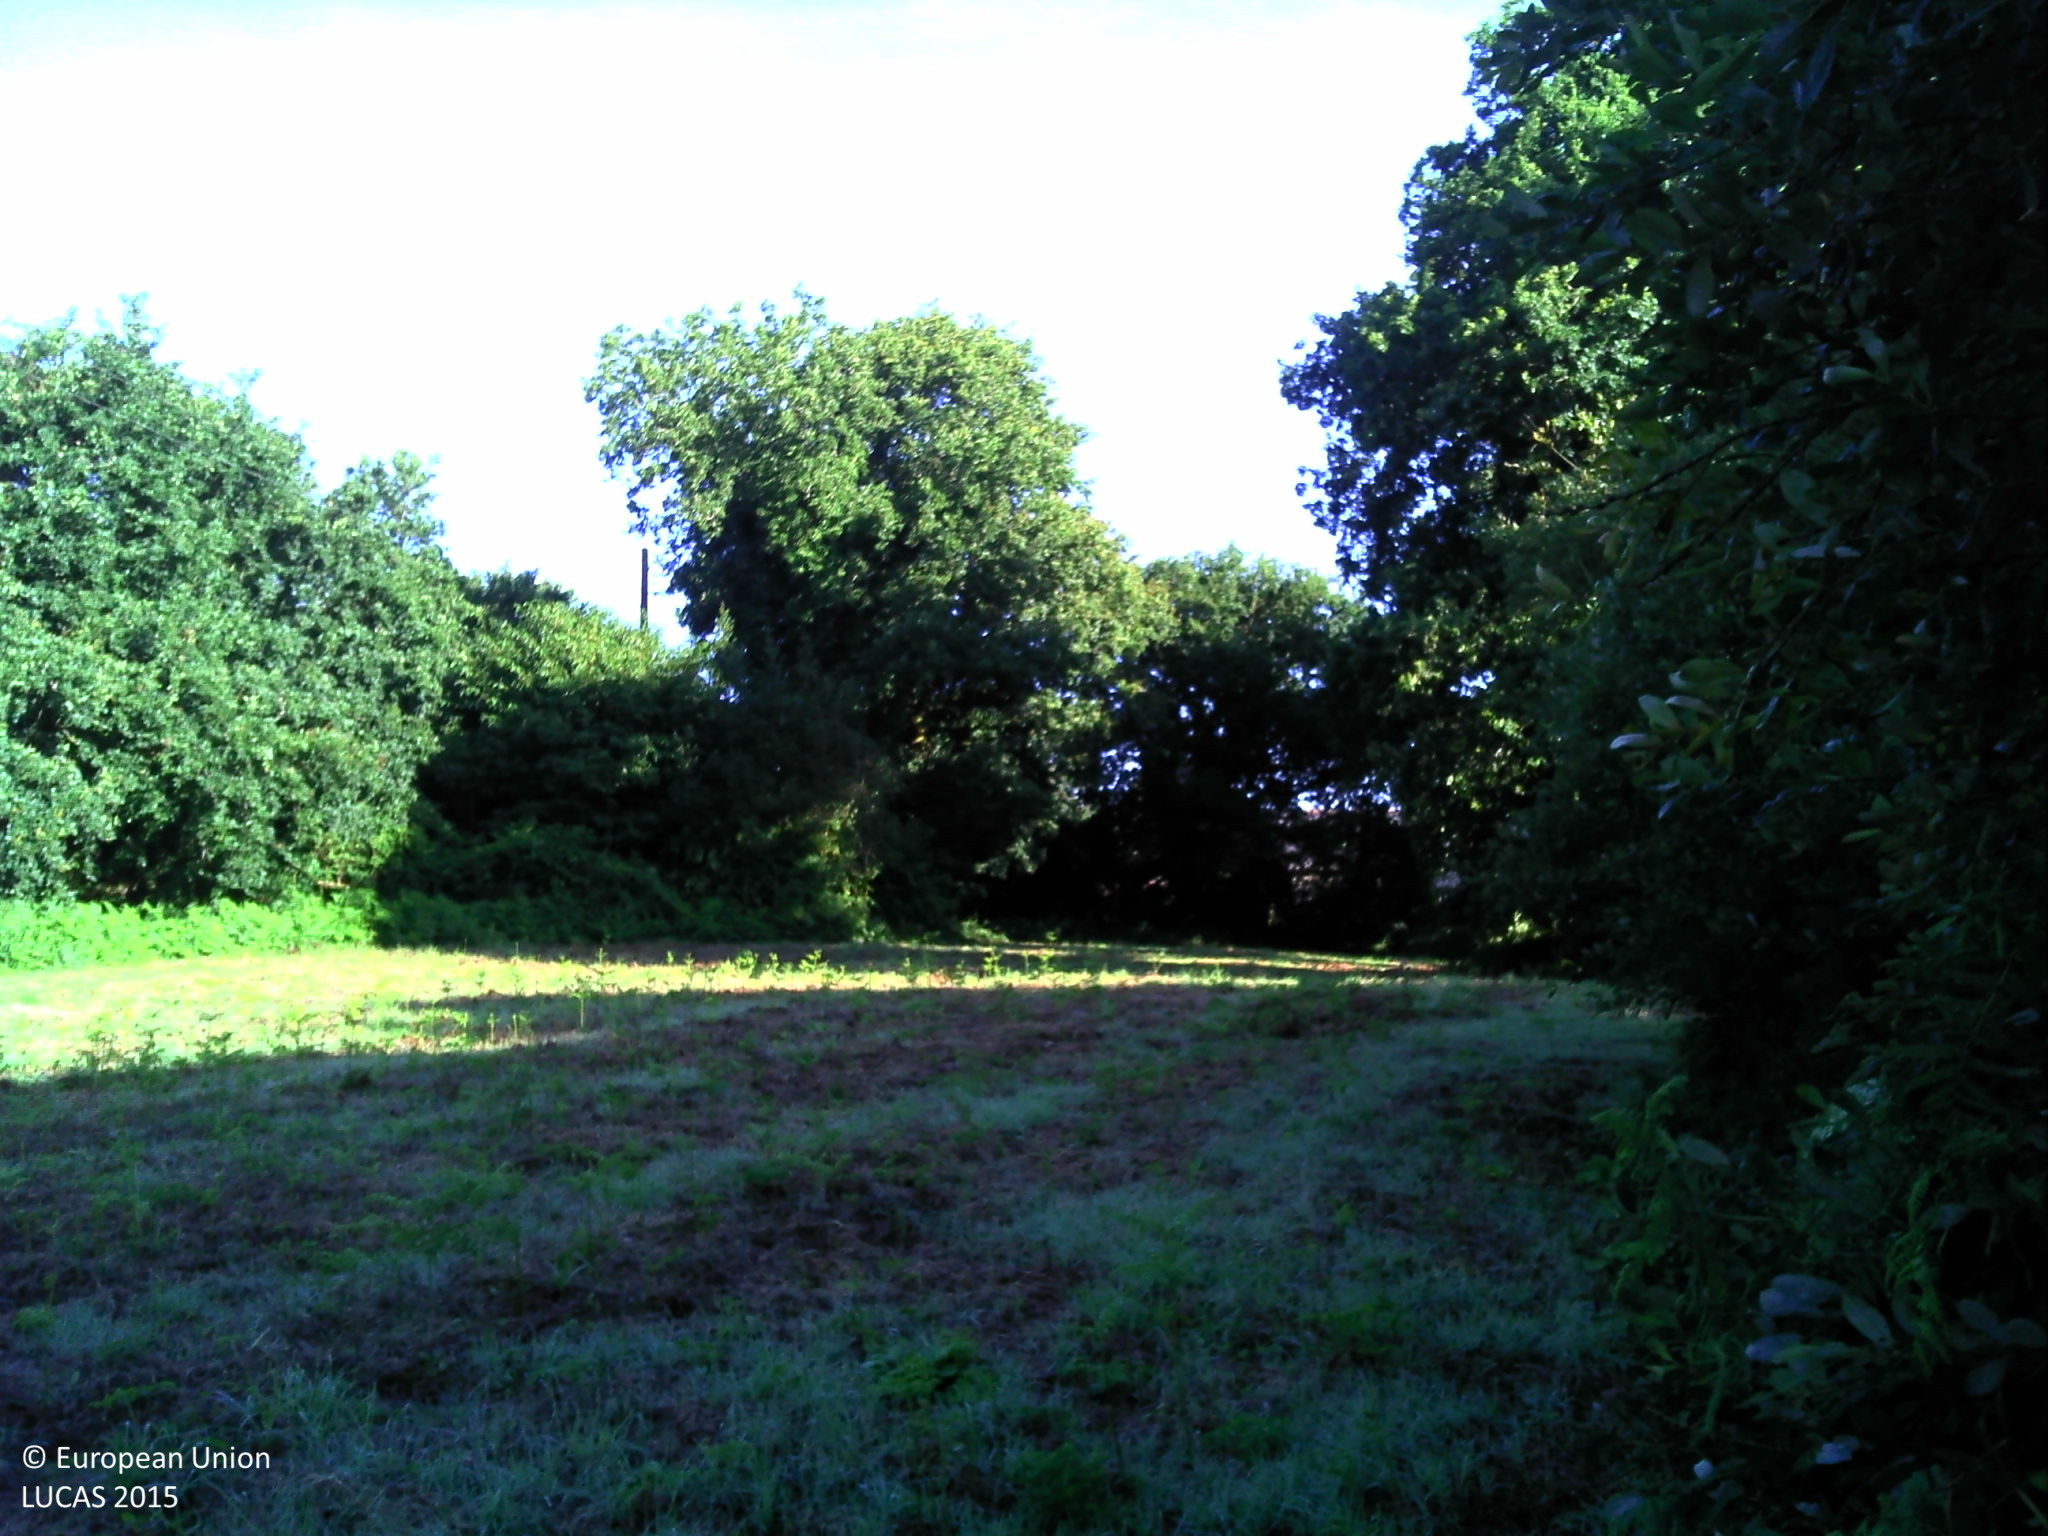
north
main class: Woodland
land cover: Broadleaved woodland
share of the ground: > 75 %
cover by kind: broadleaved forest trees 90 %, herbaceous plants 10 %
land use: Semi-natural and natural areas not in use
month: July
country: FR
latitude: 48.1621
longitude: -3.2897
